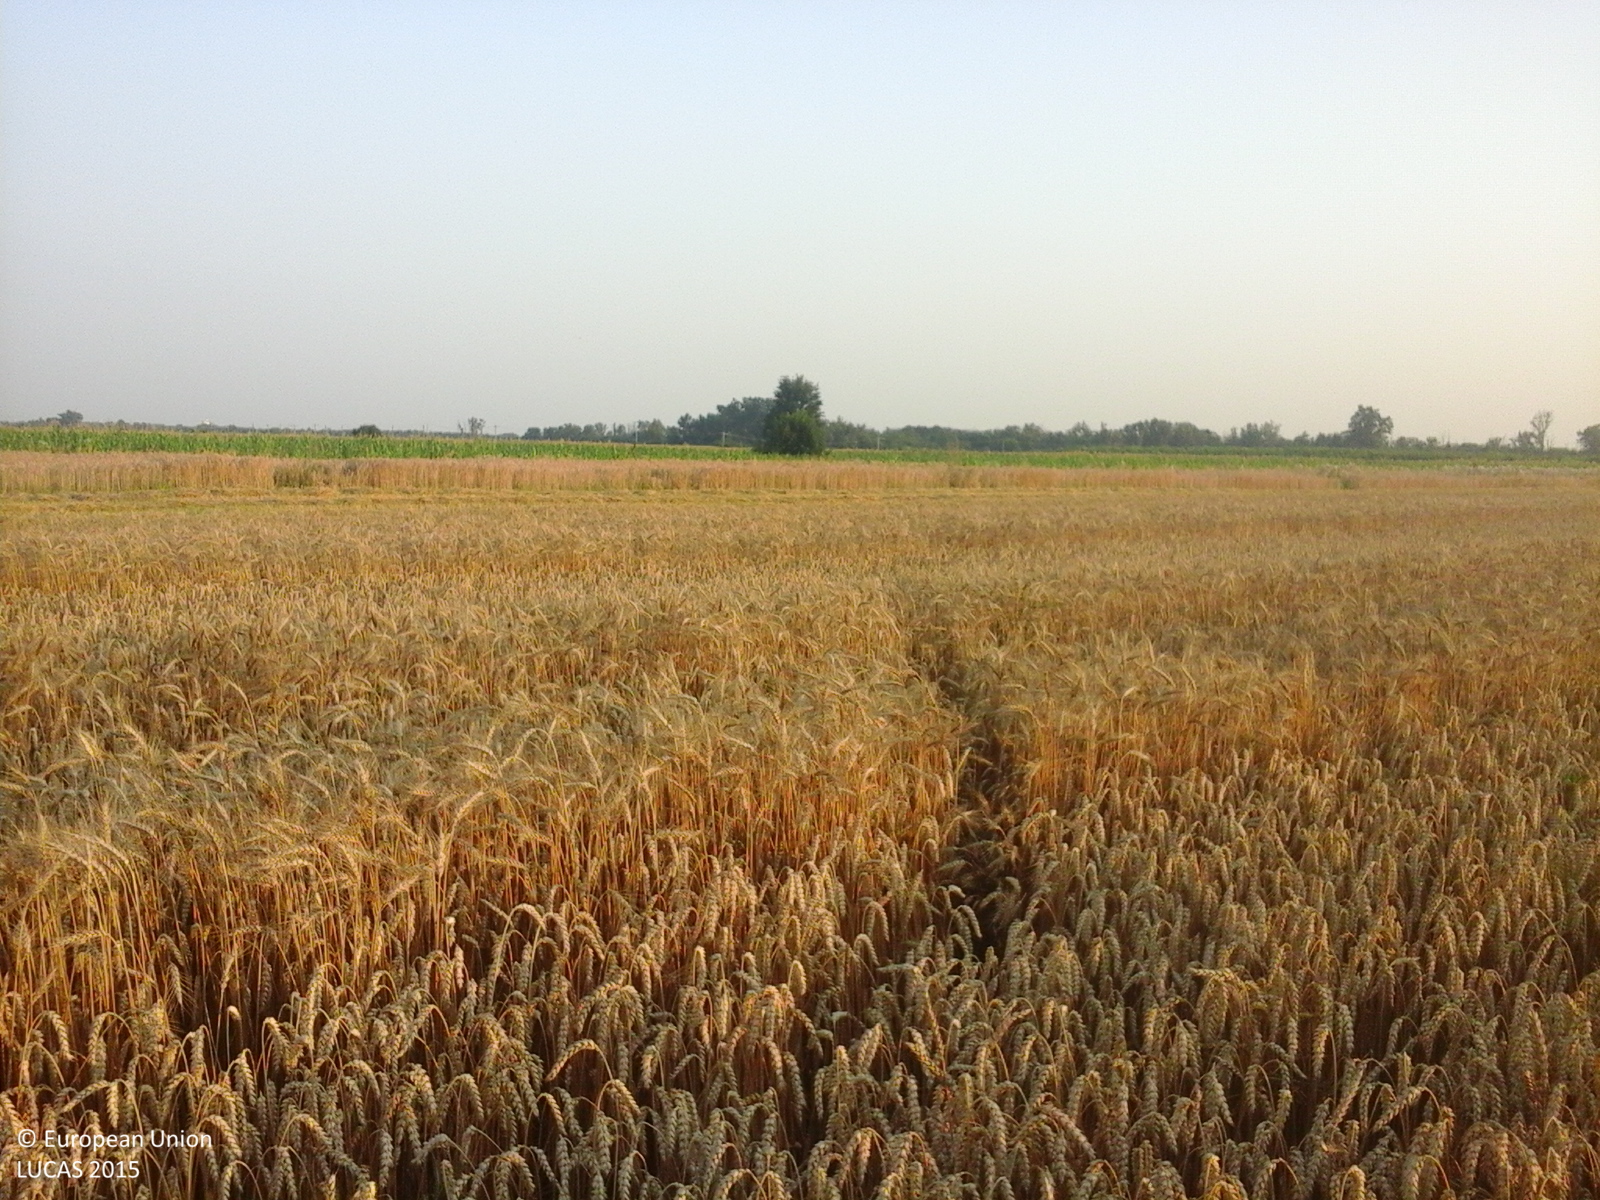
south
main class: Cropland
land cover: Common wheat
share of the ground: > 75 %
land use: Agriculture (excluding fallow land and kitchen gardens)
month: July
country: RO
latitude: 44.5647
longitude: 25.5424
